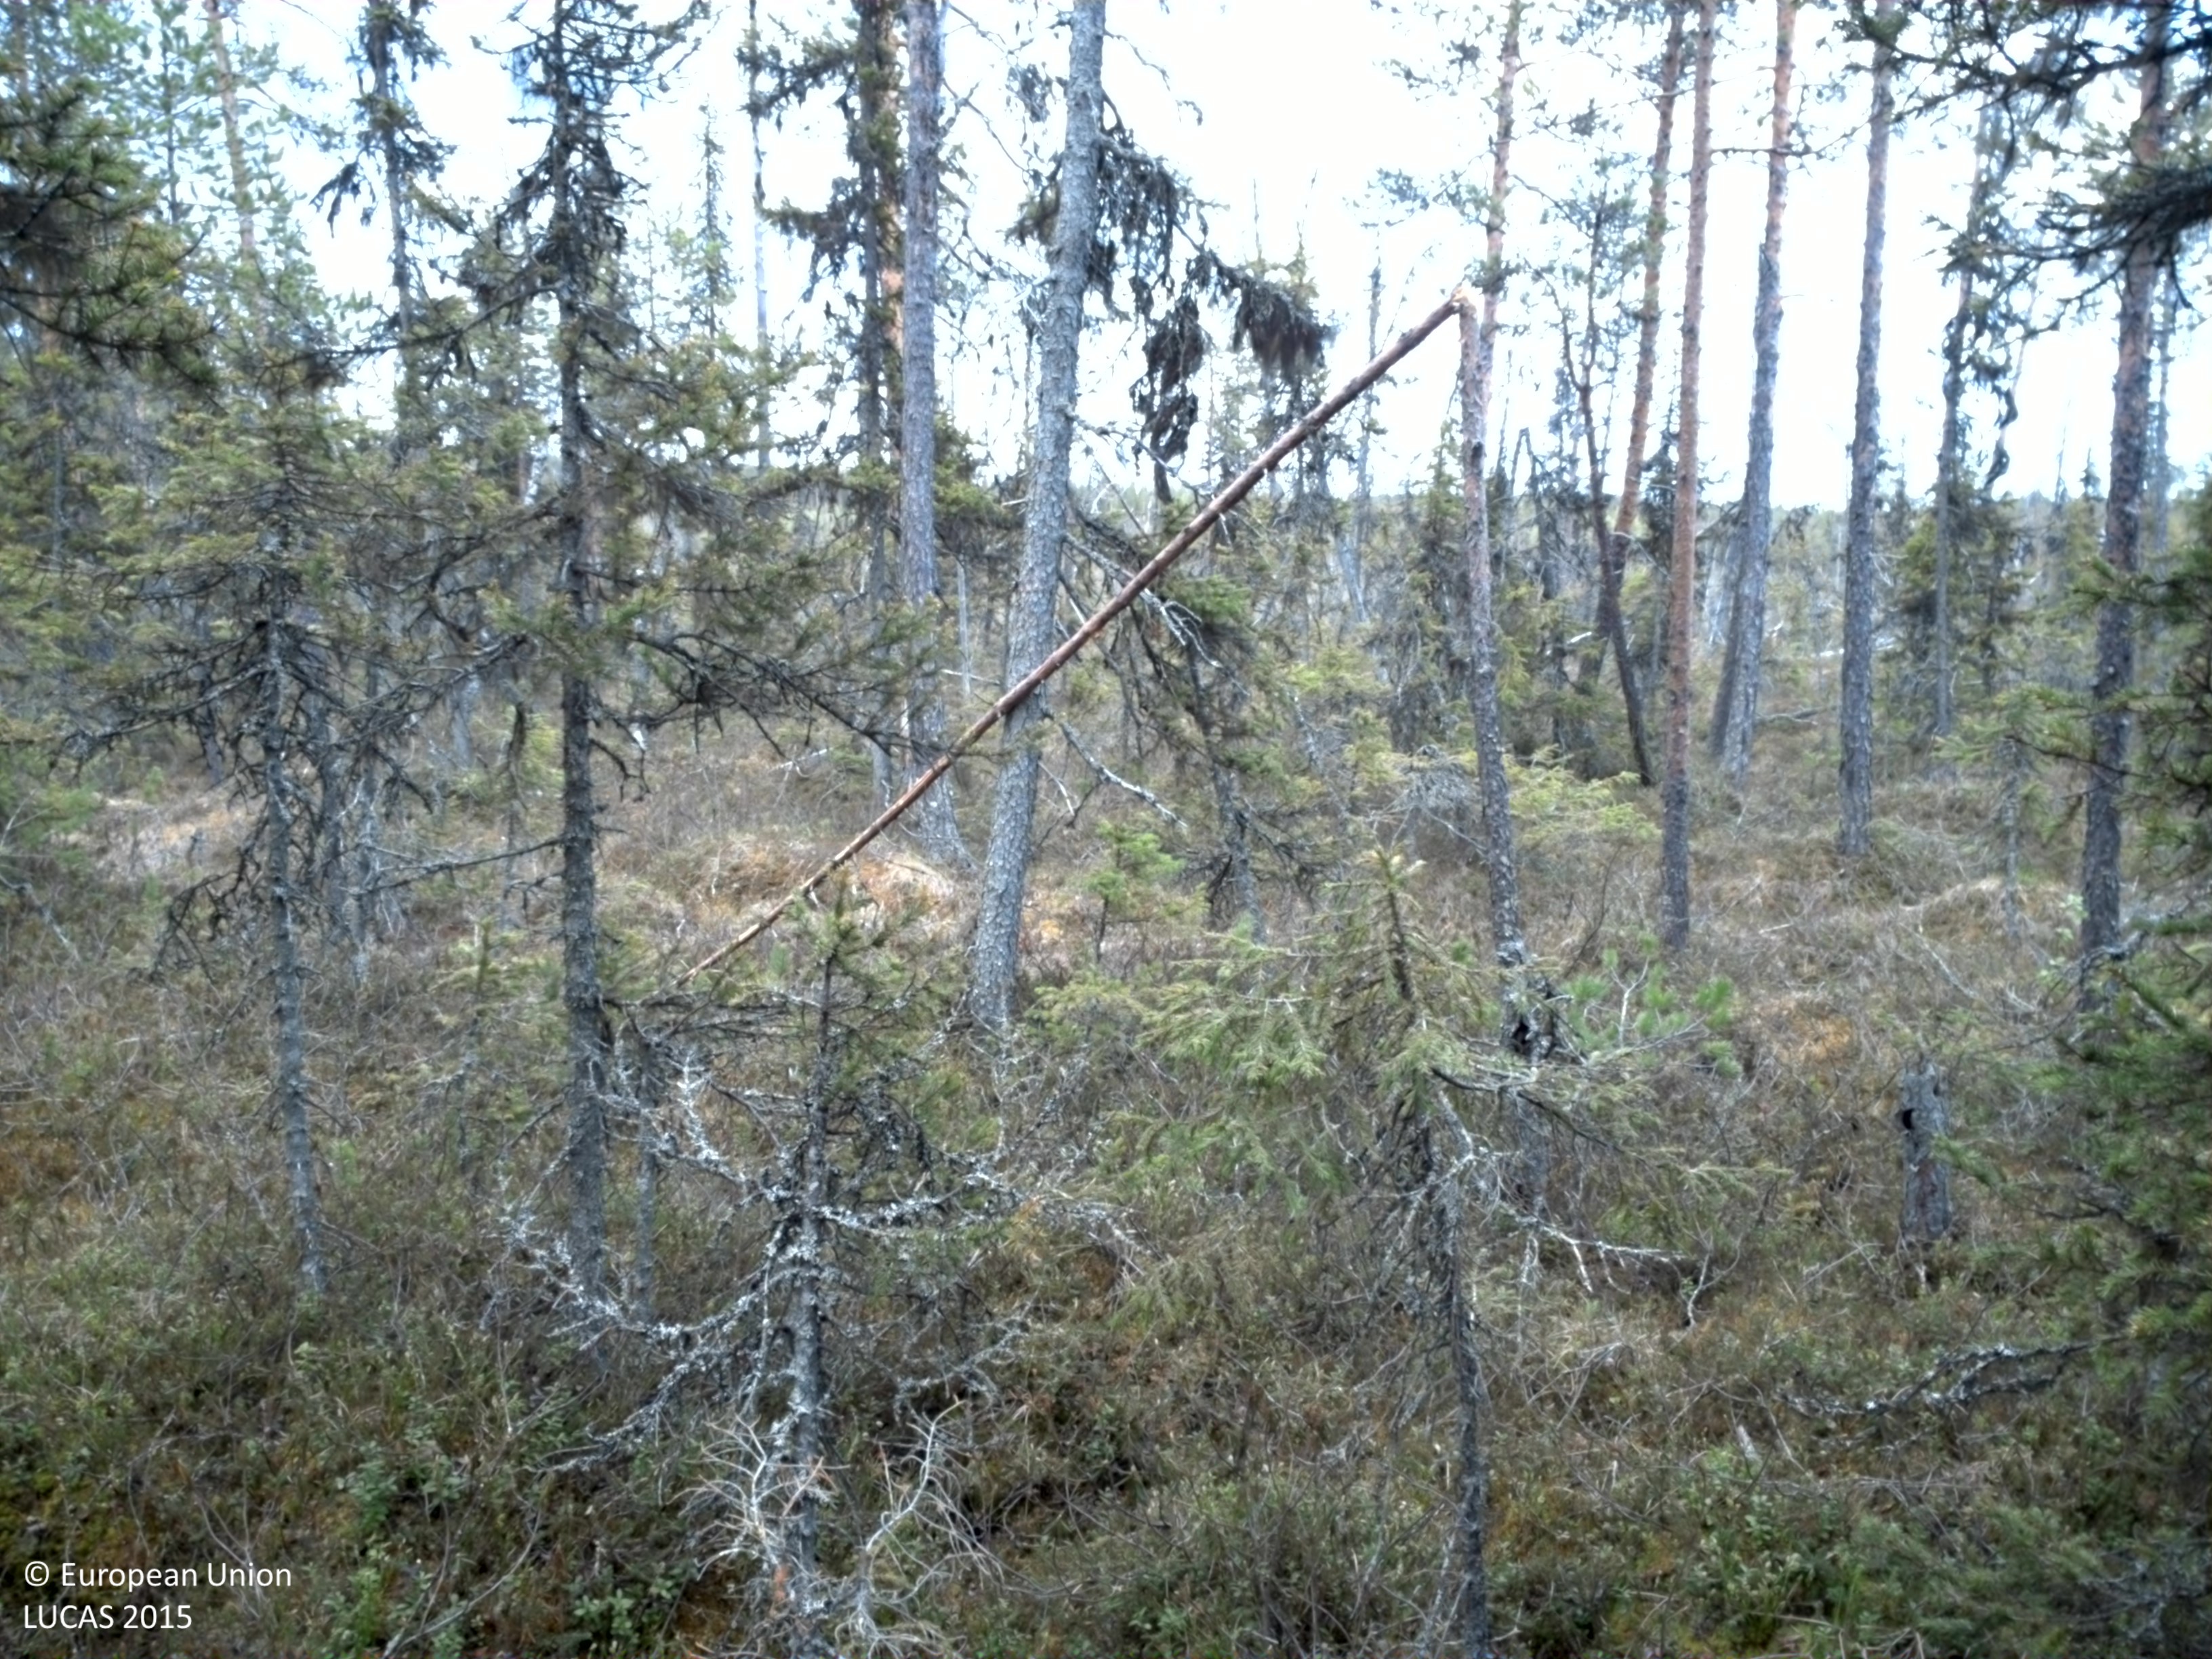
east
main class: Woodland
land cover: Other coniferous woodland
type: mire and swamp forests
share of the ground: 50 - 75 %
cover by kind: coniferous forest trees 55 %, shrubs 40 %, lichens and mosses 5 %
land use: Forestry
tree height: > 5 m
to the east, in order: Other coniferous woodland; Spruce dominated coniferous woodland; Peatbogs; Shrubland with sparse tree cover; Spruce dominated coniferous woodland
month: June
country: SE
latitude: 66.4968
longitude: 22.8971
